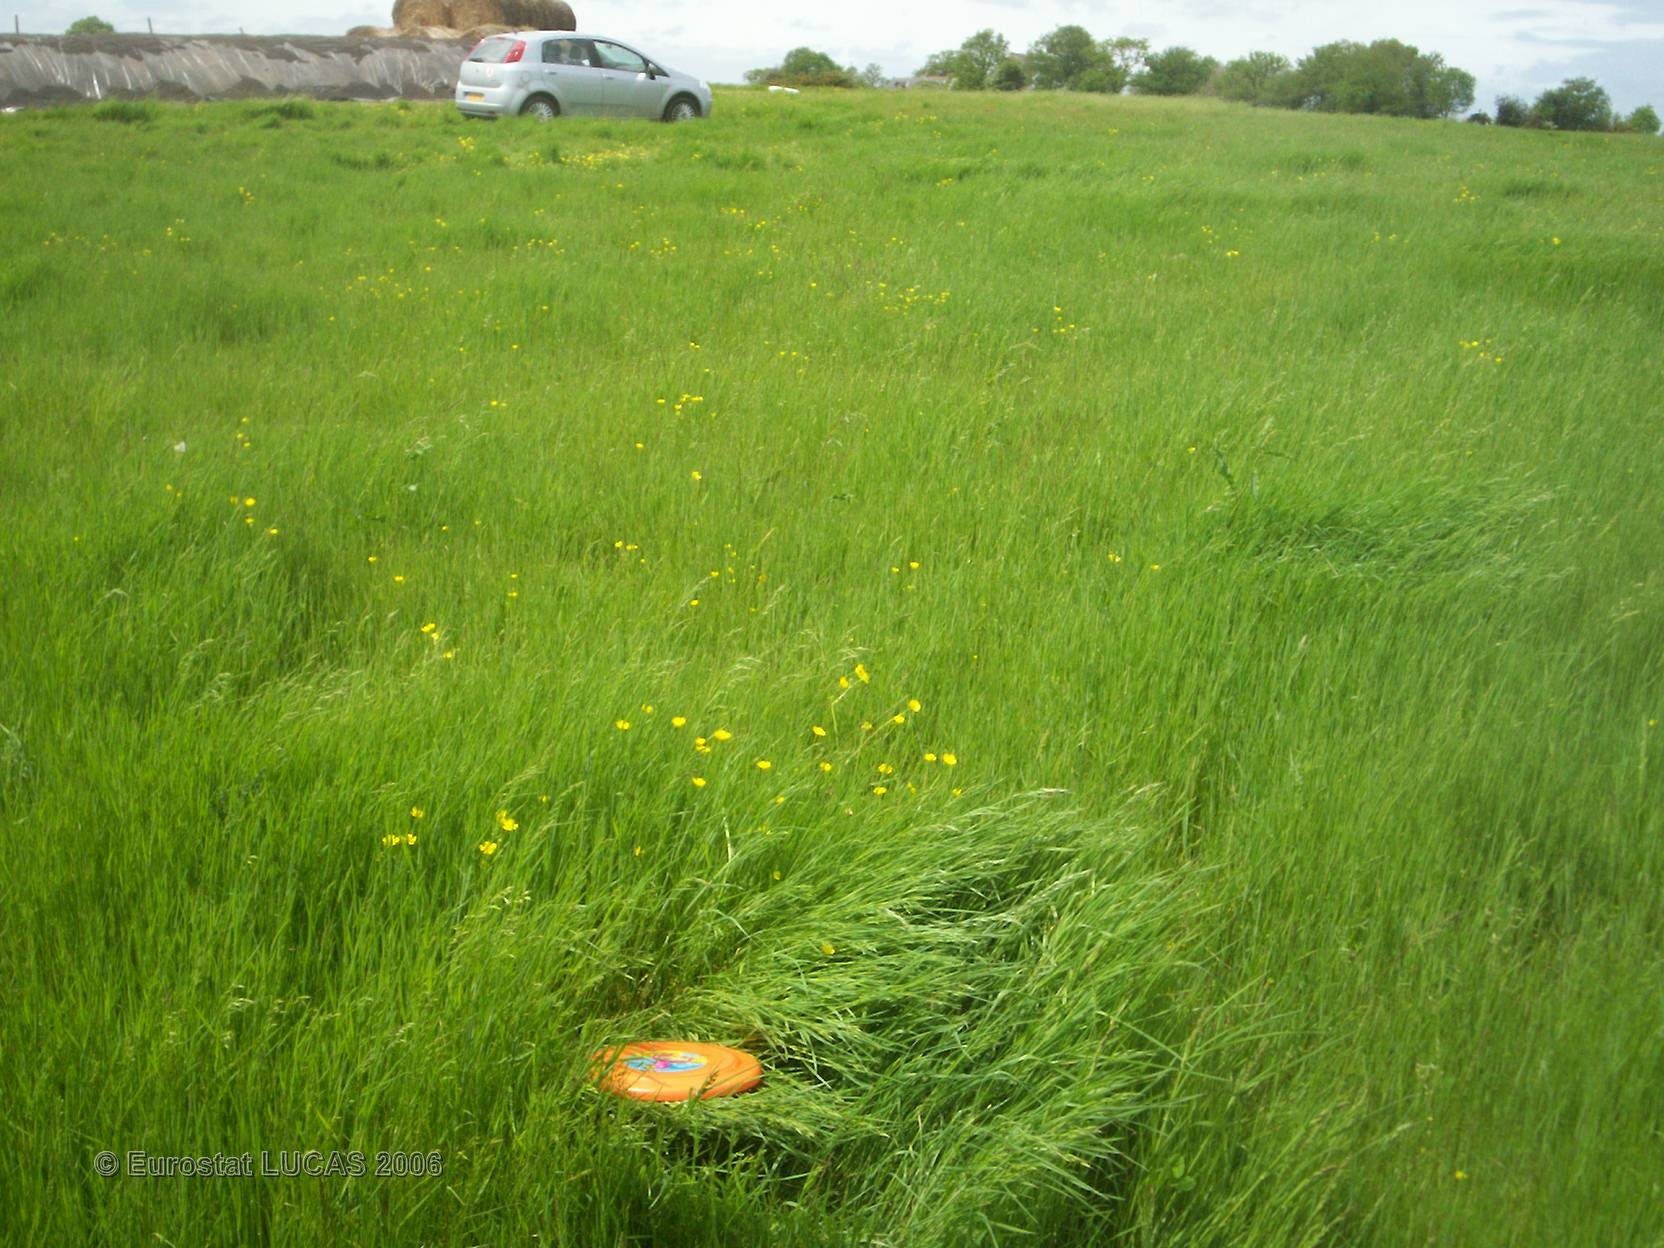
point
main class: Grassland
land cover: Grassland without tree/shrub cover
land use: Agriculture (excluding fallow land and kitchen gardens)
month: May
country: FR
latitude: 47.6728
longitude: -1.5113
